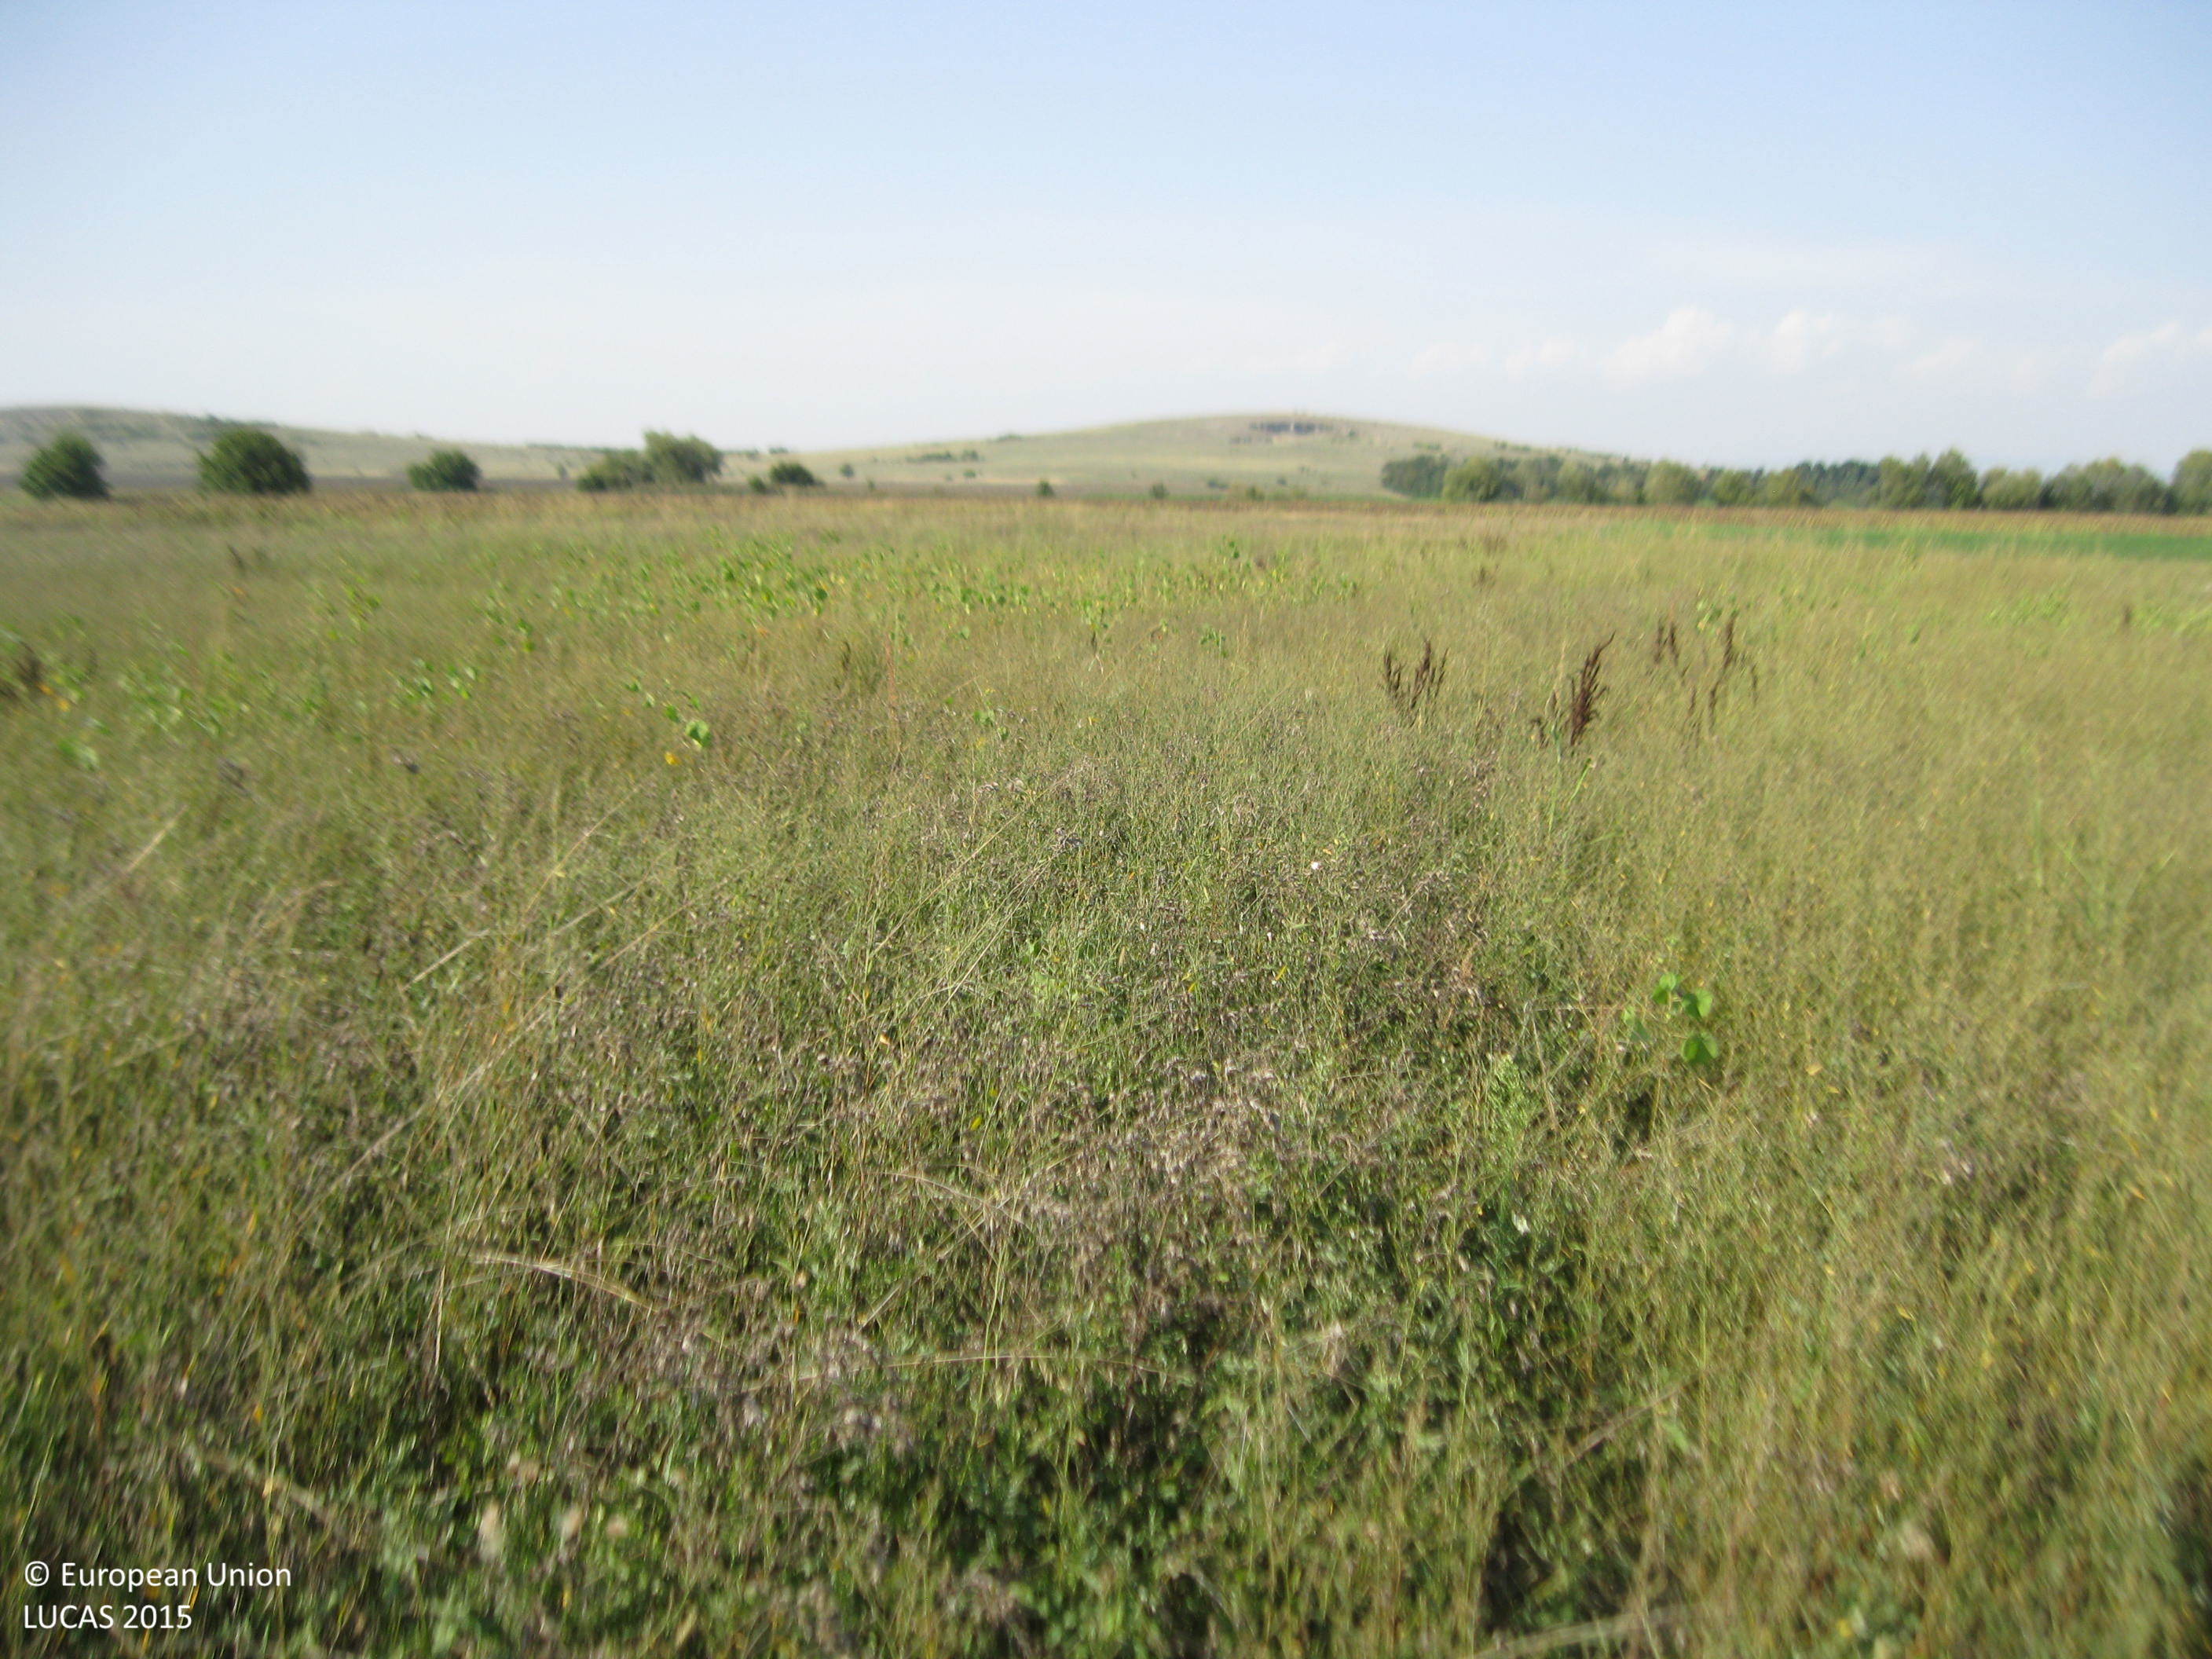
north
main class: Grassland
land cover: Spontaneously vegetated surfaces
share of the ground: > 75 %
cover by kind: herbaceous plants 100 %
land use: Fallow land
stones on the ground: < 10 %
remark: Harvested field
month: September
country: BG
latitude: 42.2199
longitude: 25.0435
